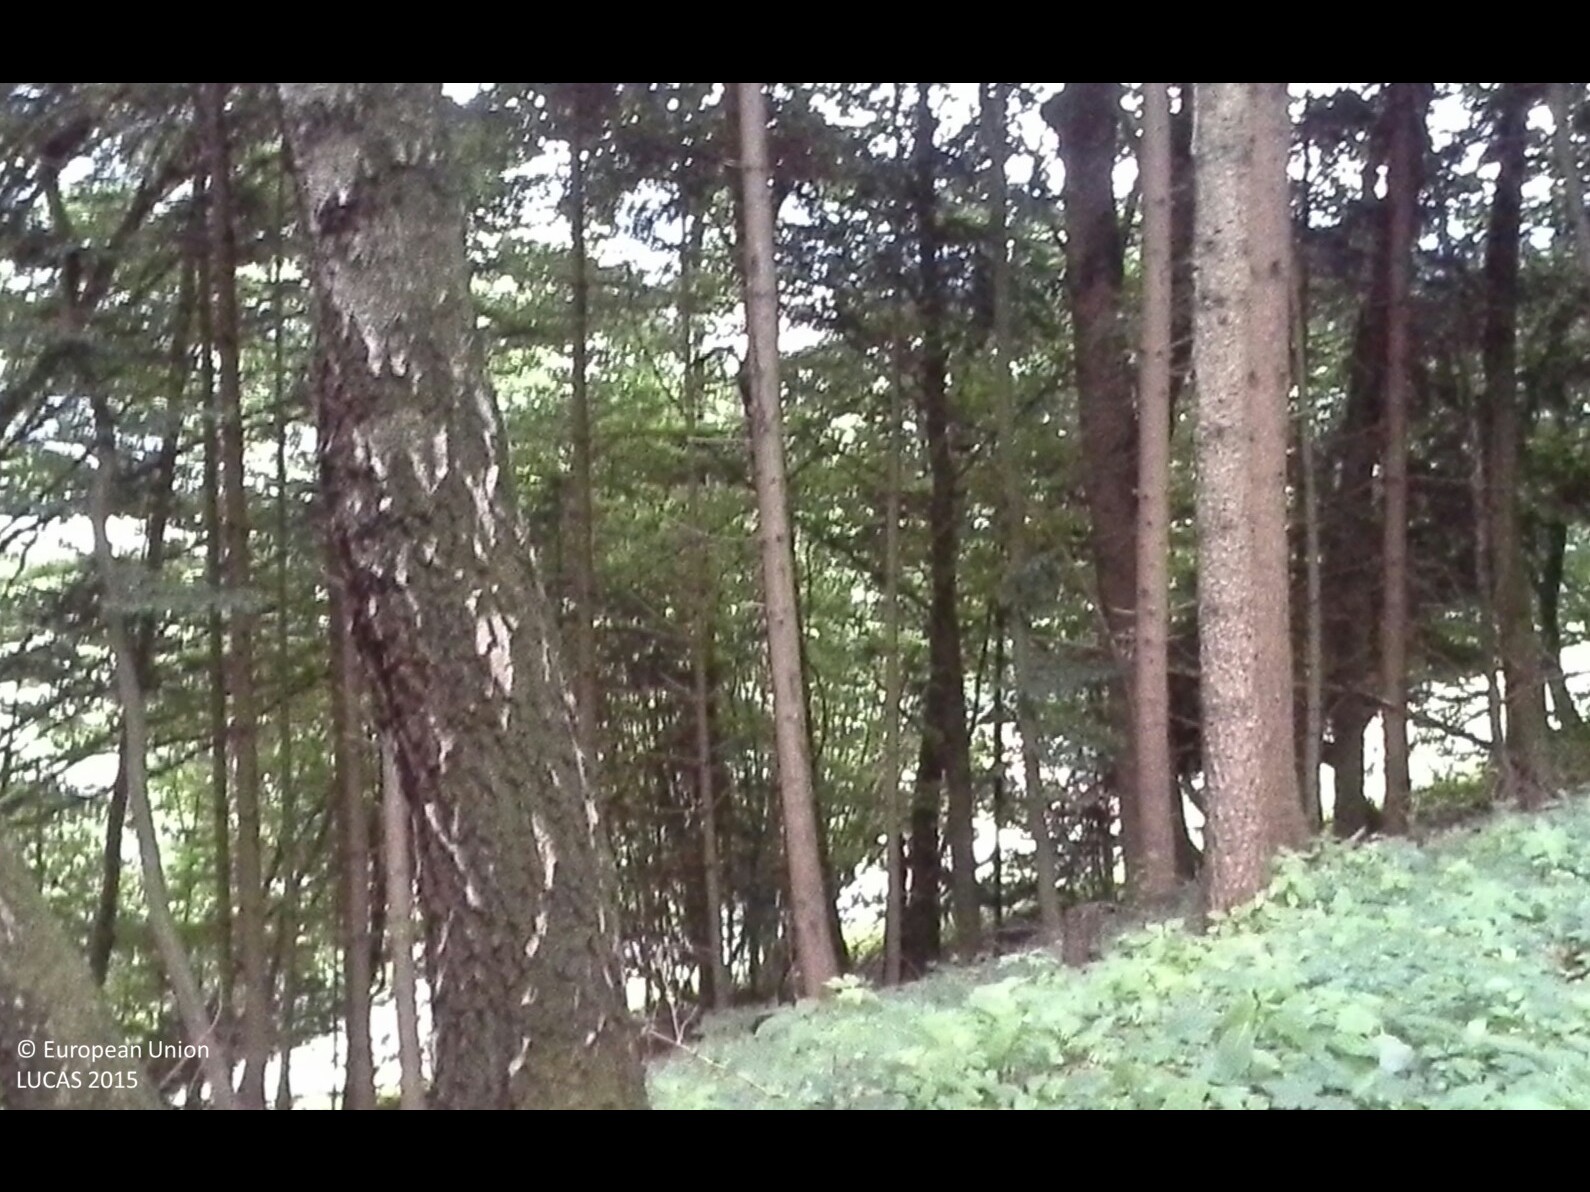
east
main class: Woodland
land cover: Spruce dominated mixed woodland
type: beech forest
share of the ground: > 75 %
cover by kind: broadleaved forest trees 55 %, coniferous forest trees 30 %, herbaceous plants 15 %
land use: Forestry
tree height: > 5 m
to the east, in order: Spruce dominated mixed woodland; Rivers and streams; Spruce dominated mixed woodland; Fences; Broadleaved woodland; Grassland without tree/shrub cover; Fences; Grassland without tree/shrub cover; Fences; Spruce dominated coniferous woodland; Tracks; Broadleaved woodland; Artificial constructions in urban areas
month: June
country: AT
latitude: 47.9912
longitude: 14.4086
